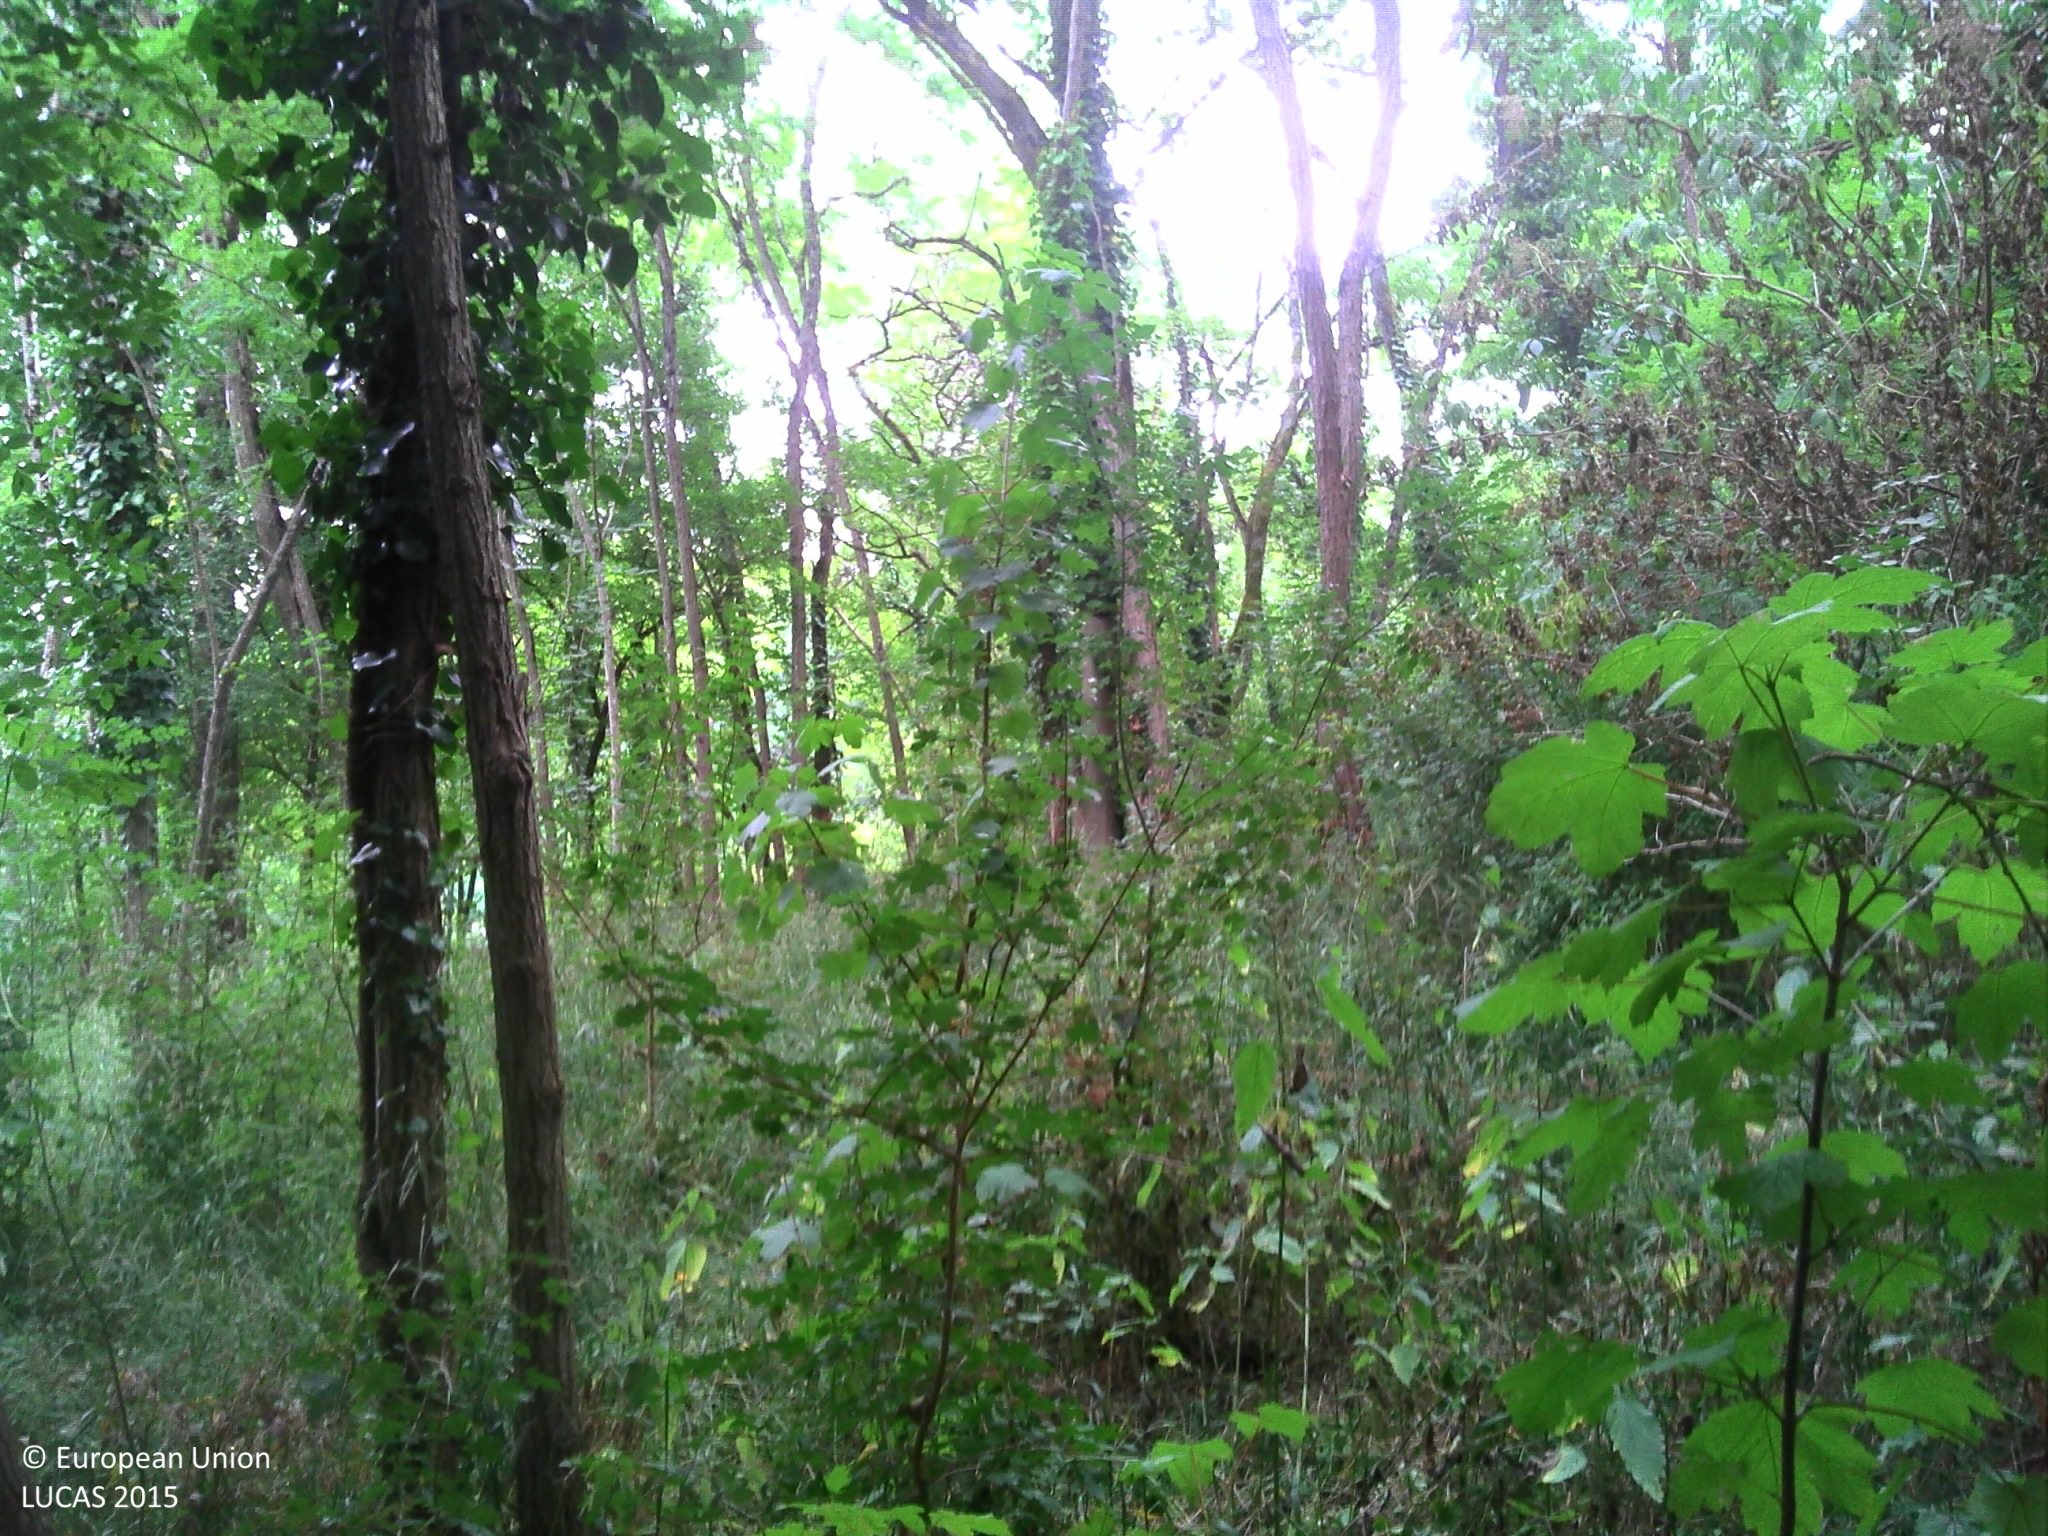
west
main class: Woodland
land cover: Broadleaved woodland
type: mesophytic deciduous forest
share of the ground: > 75 %
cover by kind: broadleaved forest trees 75 %, shrubs 10 %, herbaceous plants 10 %, lichens and mosses 5 %
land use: Forestry
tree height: > 5 m
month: July
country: FR
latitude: 47.3110
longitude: 0.3614
